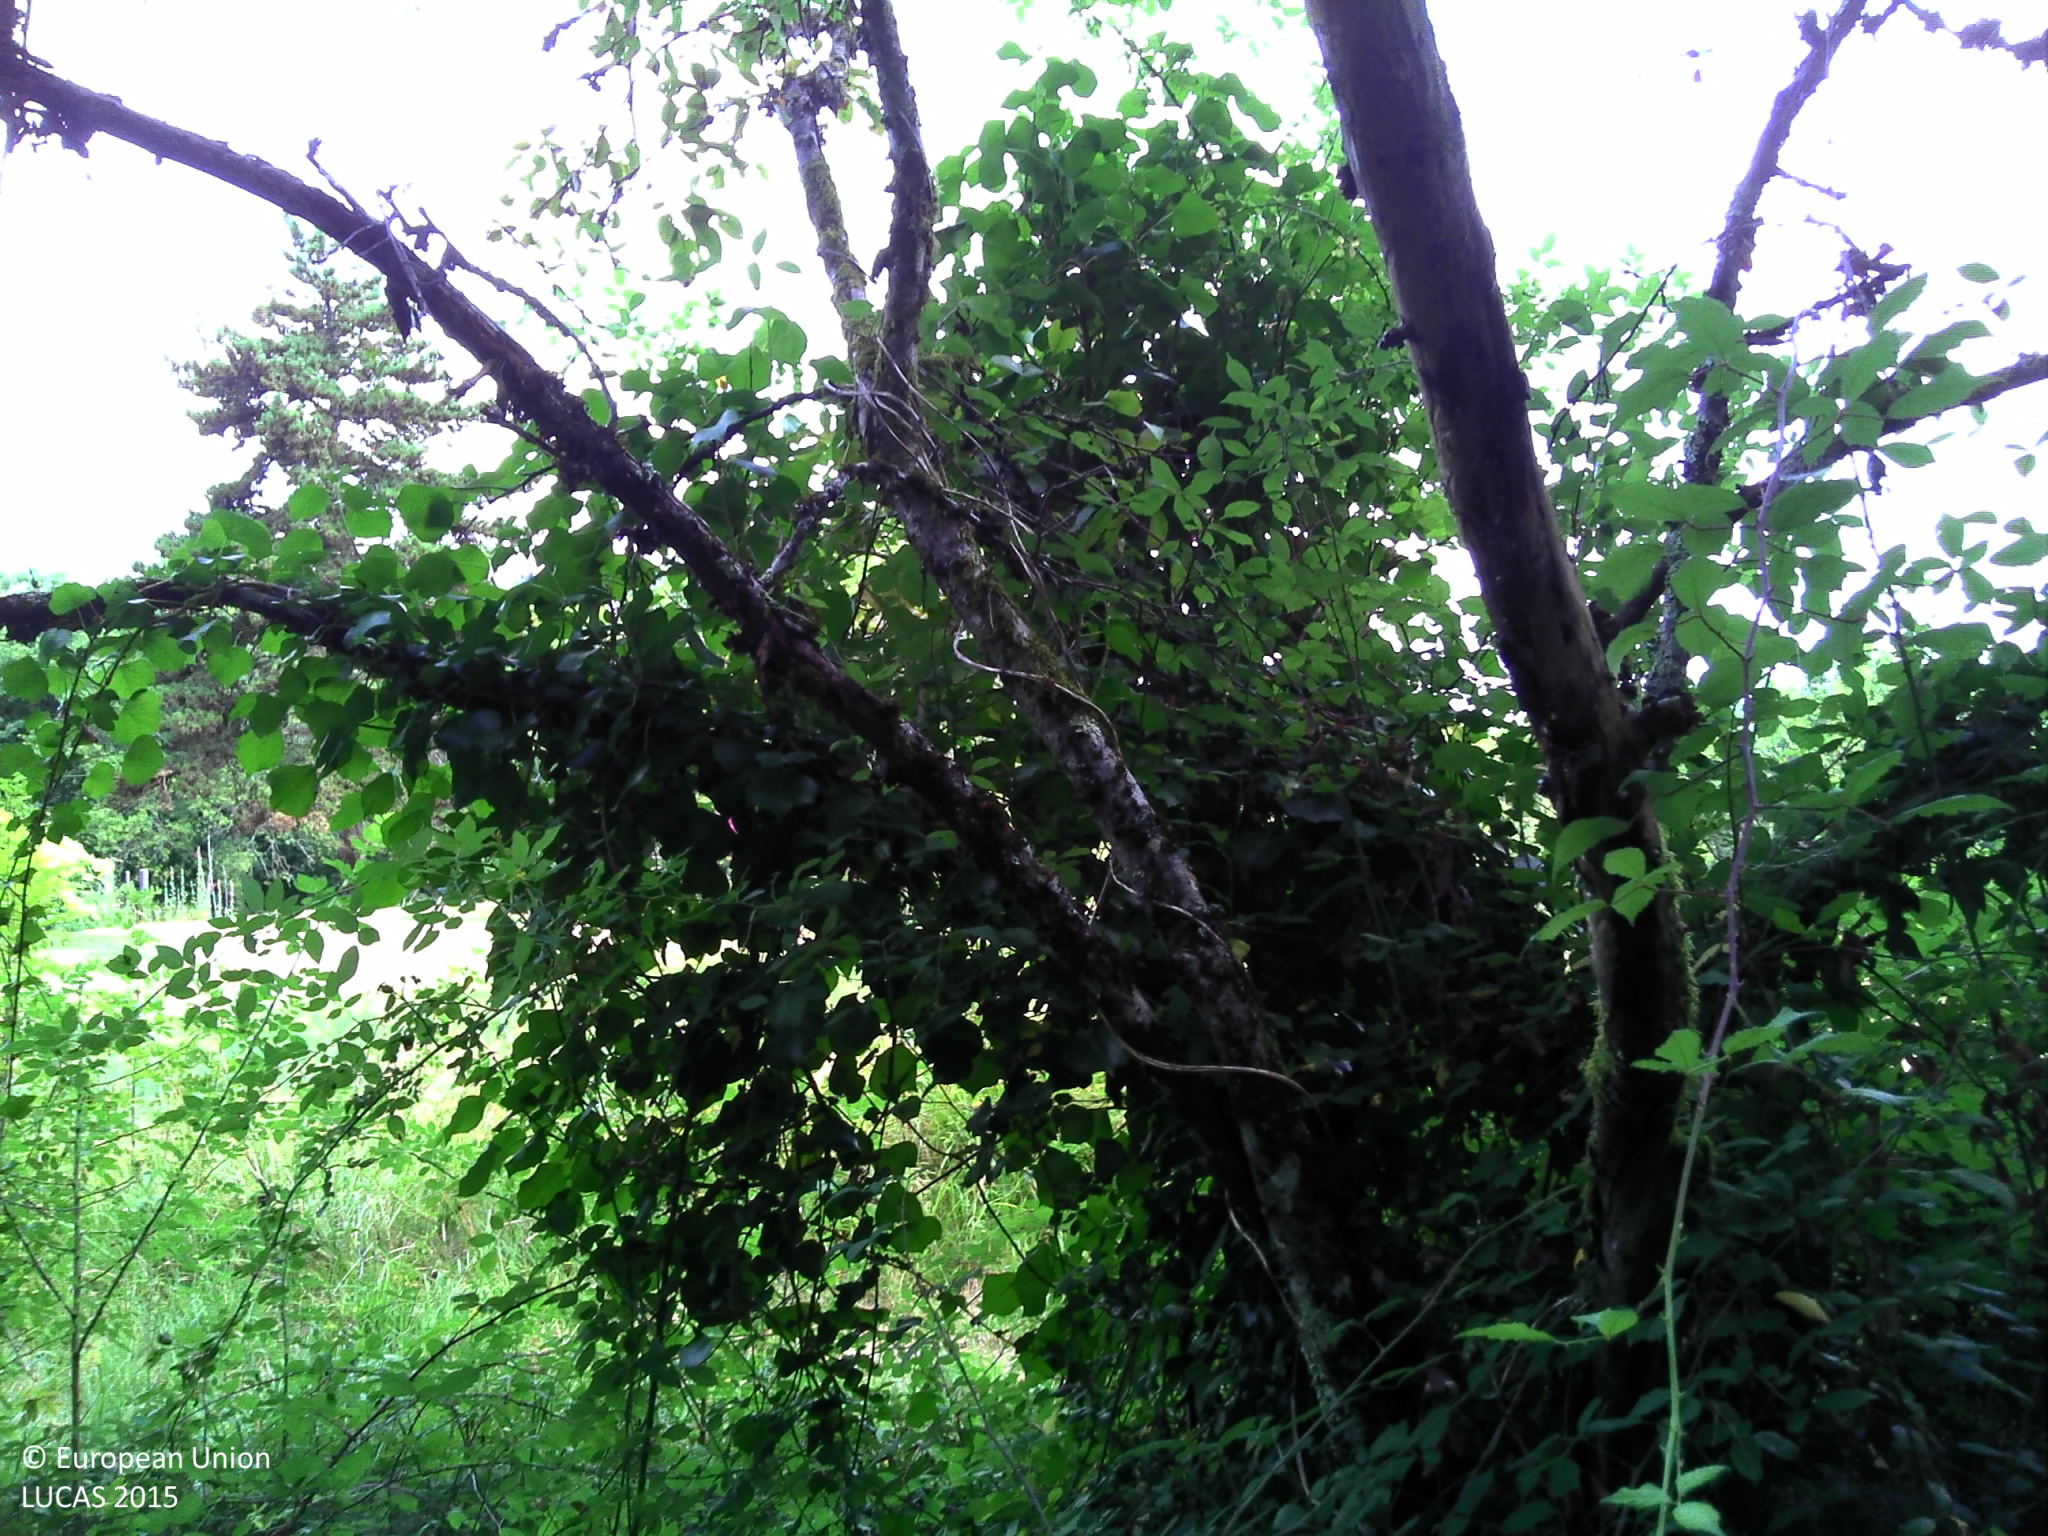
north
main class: Grassland
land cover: Grassland with sparse tree/shrub cover
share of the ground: > 75 %
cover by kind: herbaceous plants 85 %, lichens and mosses 10 %, broadleaved forest trees 5 %
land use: Semi-natural and natural areas not in use
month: July
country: FR
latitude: 45.1127
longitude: 1.1338
